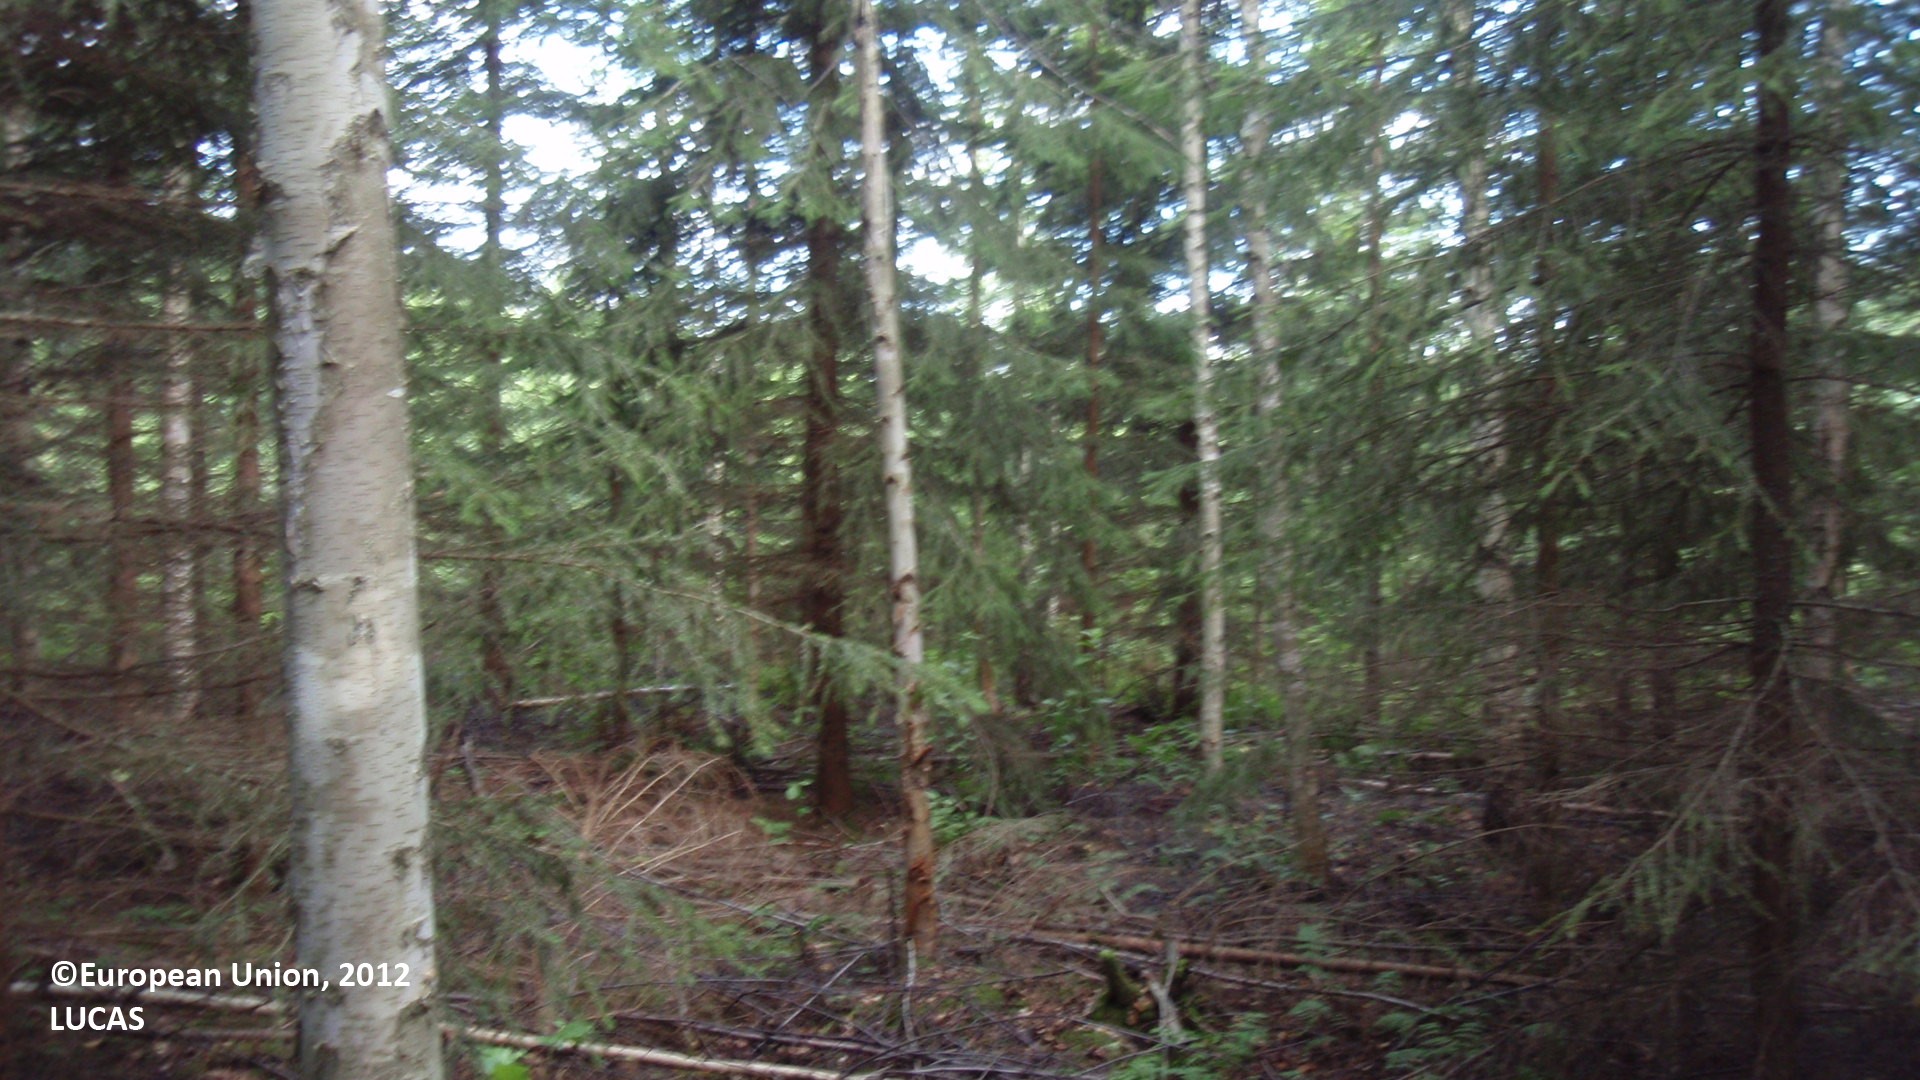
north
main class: Woodland
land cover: Spruce dominated mixed woodland
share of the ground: > 75 %
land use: Forestry
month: August
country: FI
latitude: 61.3060
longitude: 27.7183
